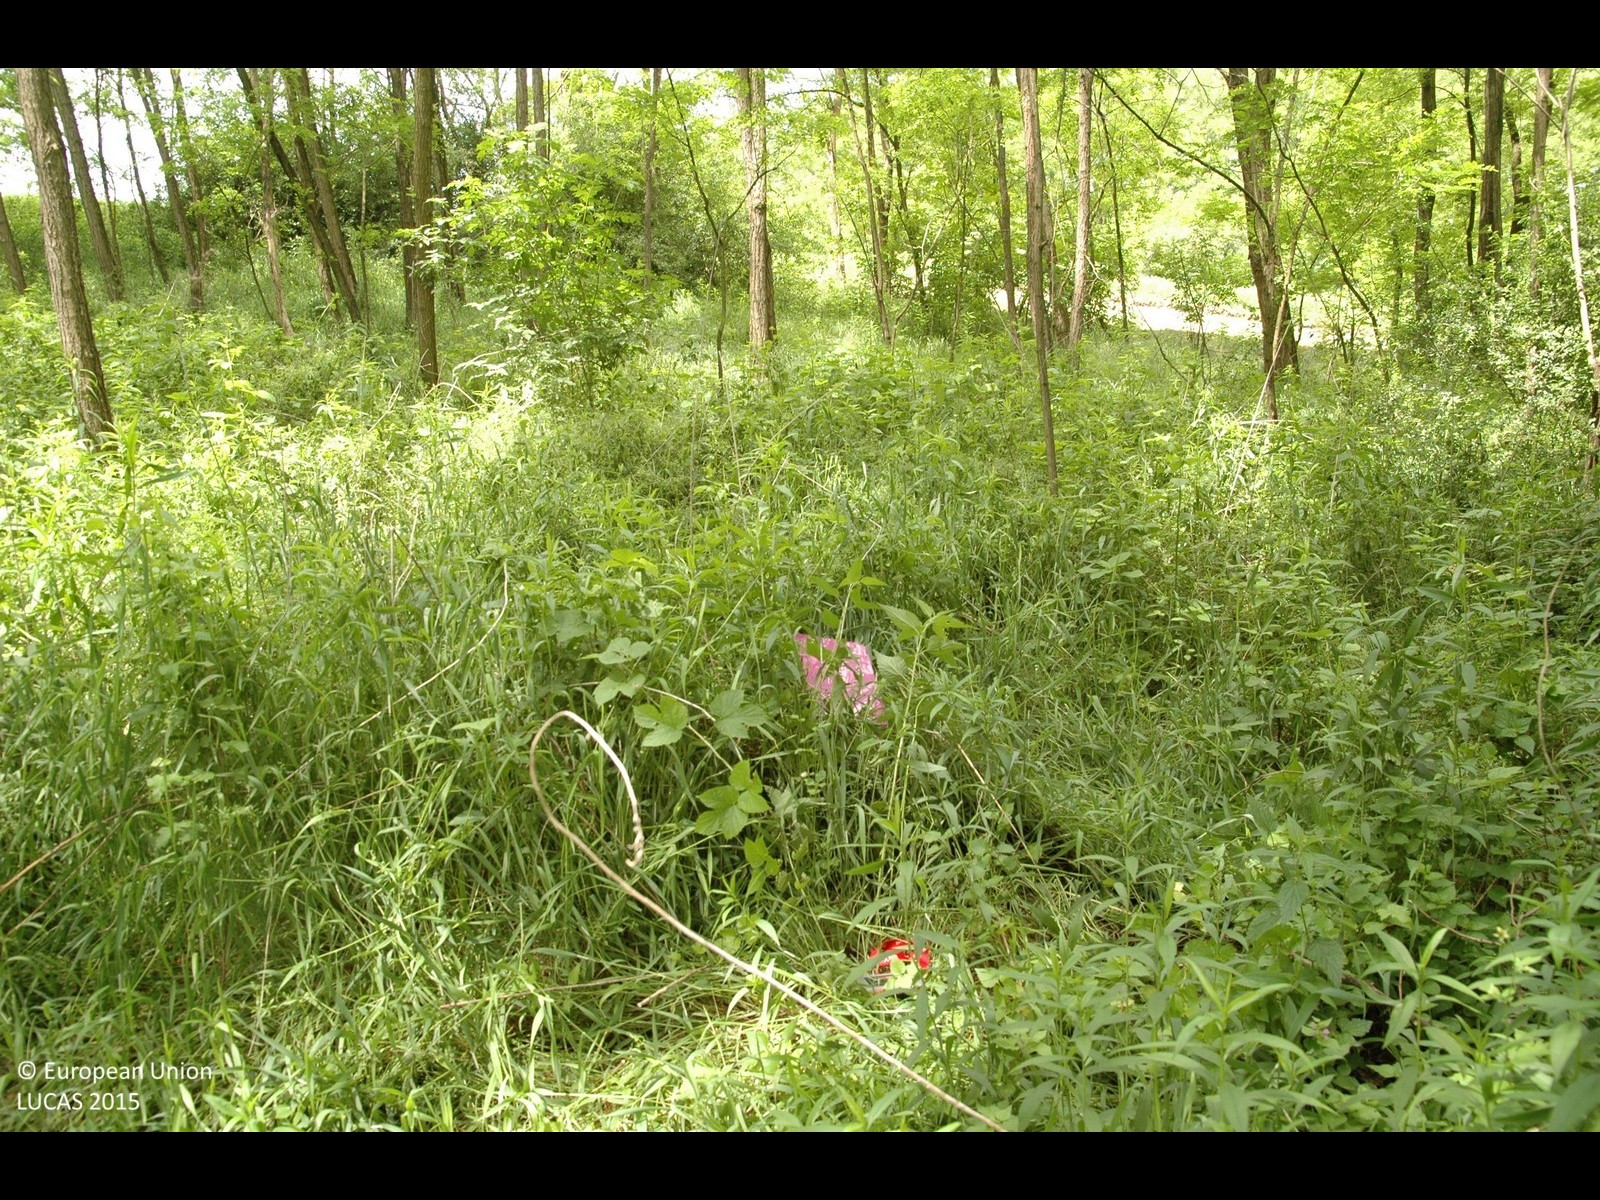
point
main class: Woodland
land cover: Broadleaved woodland
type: mesophytic deciduous forest
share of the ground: > 75 %
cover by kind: broadleaved forest trees 90 %, shrubs 5 %, herbaceous plants 5 %
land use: Forestry
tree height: > 5 m
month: May
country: HR
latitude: 46.4100
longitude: 16.4401
